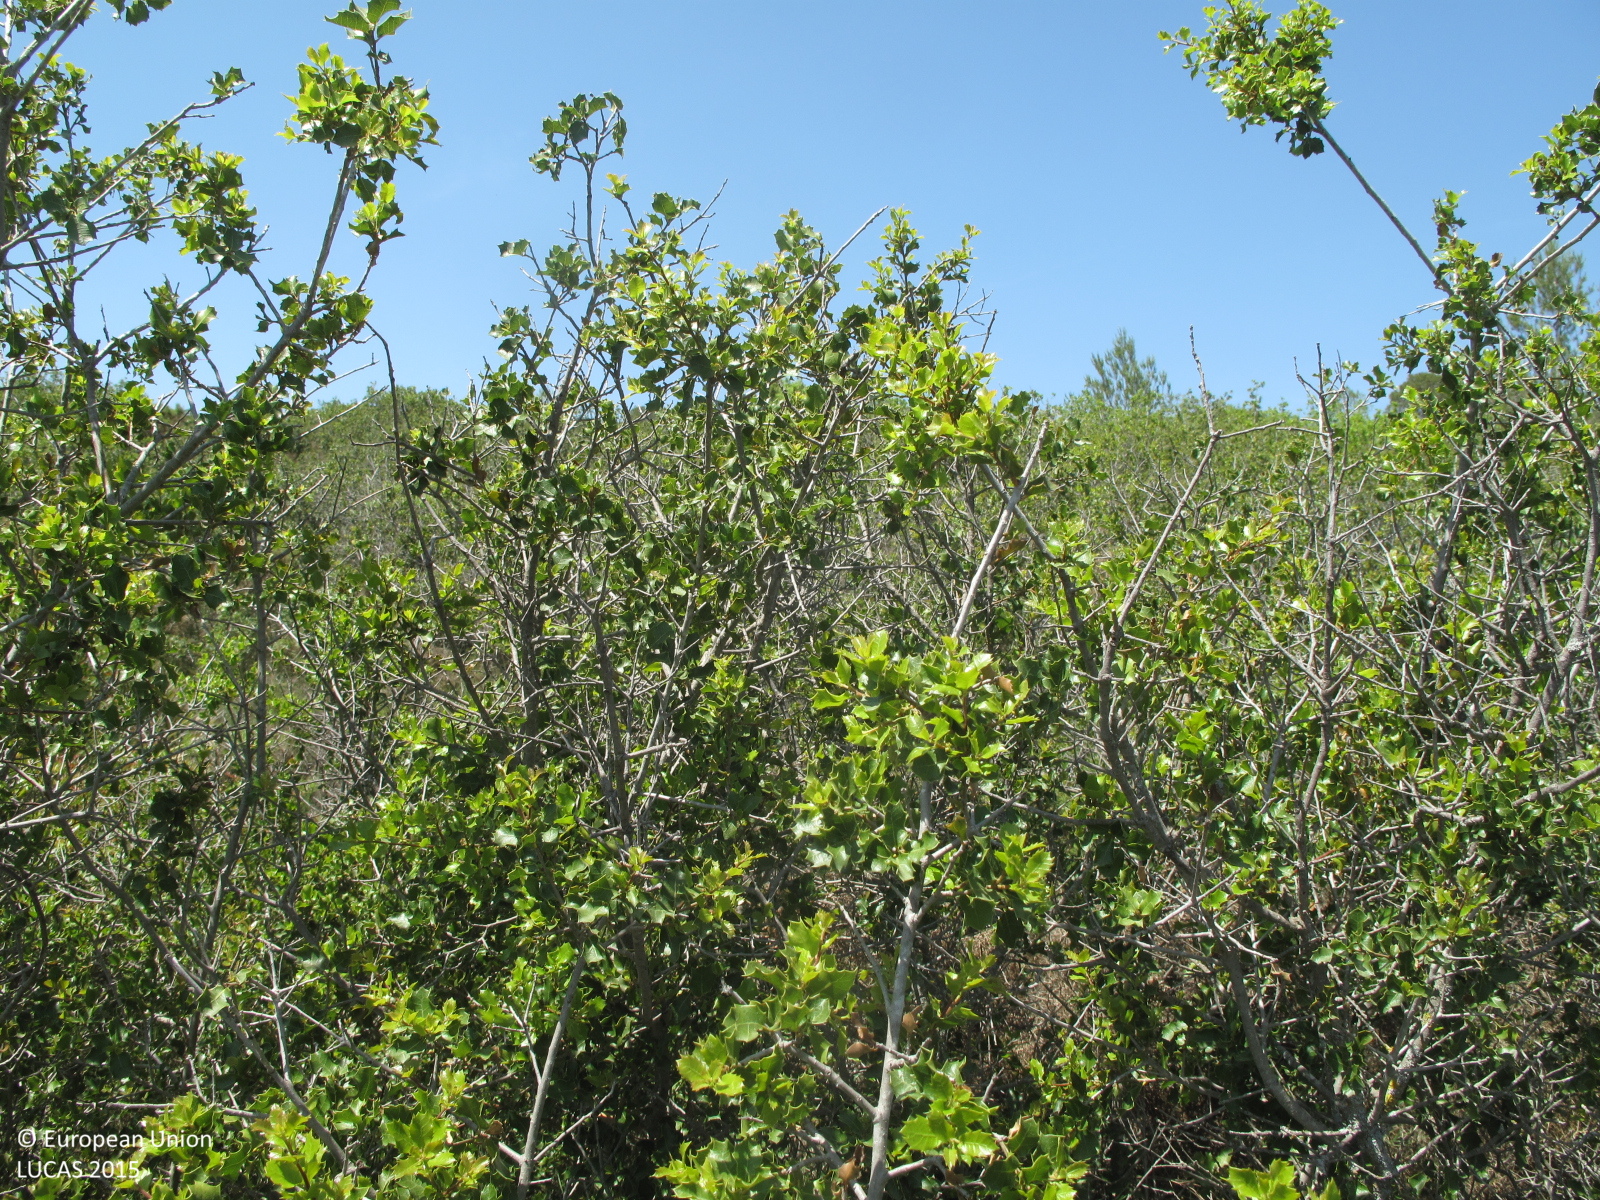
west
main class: Shrubland
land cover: Shrubland with sparse tree cover
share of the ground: > 75 %
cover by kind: shrubs 80 %, consolidated bare surface 15 %, broadleaved forest trees 5 %
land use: Semi-natural and natural areas not in use
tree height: < 5 m
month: May
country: ES
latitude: 38.9467
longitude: -0.7351
